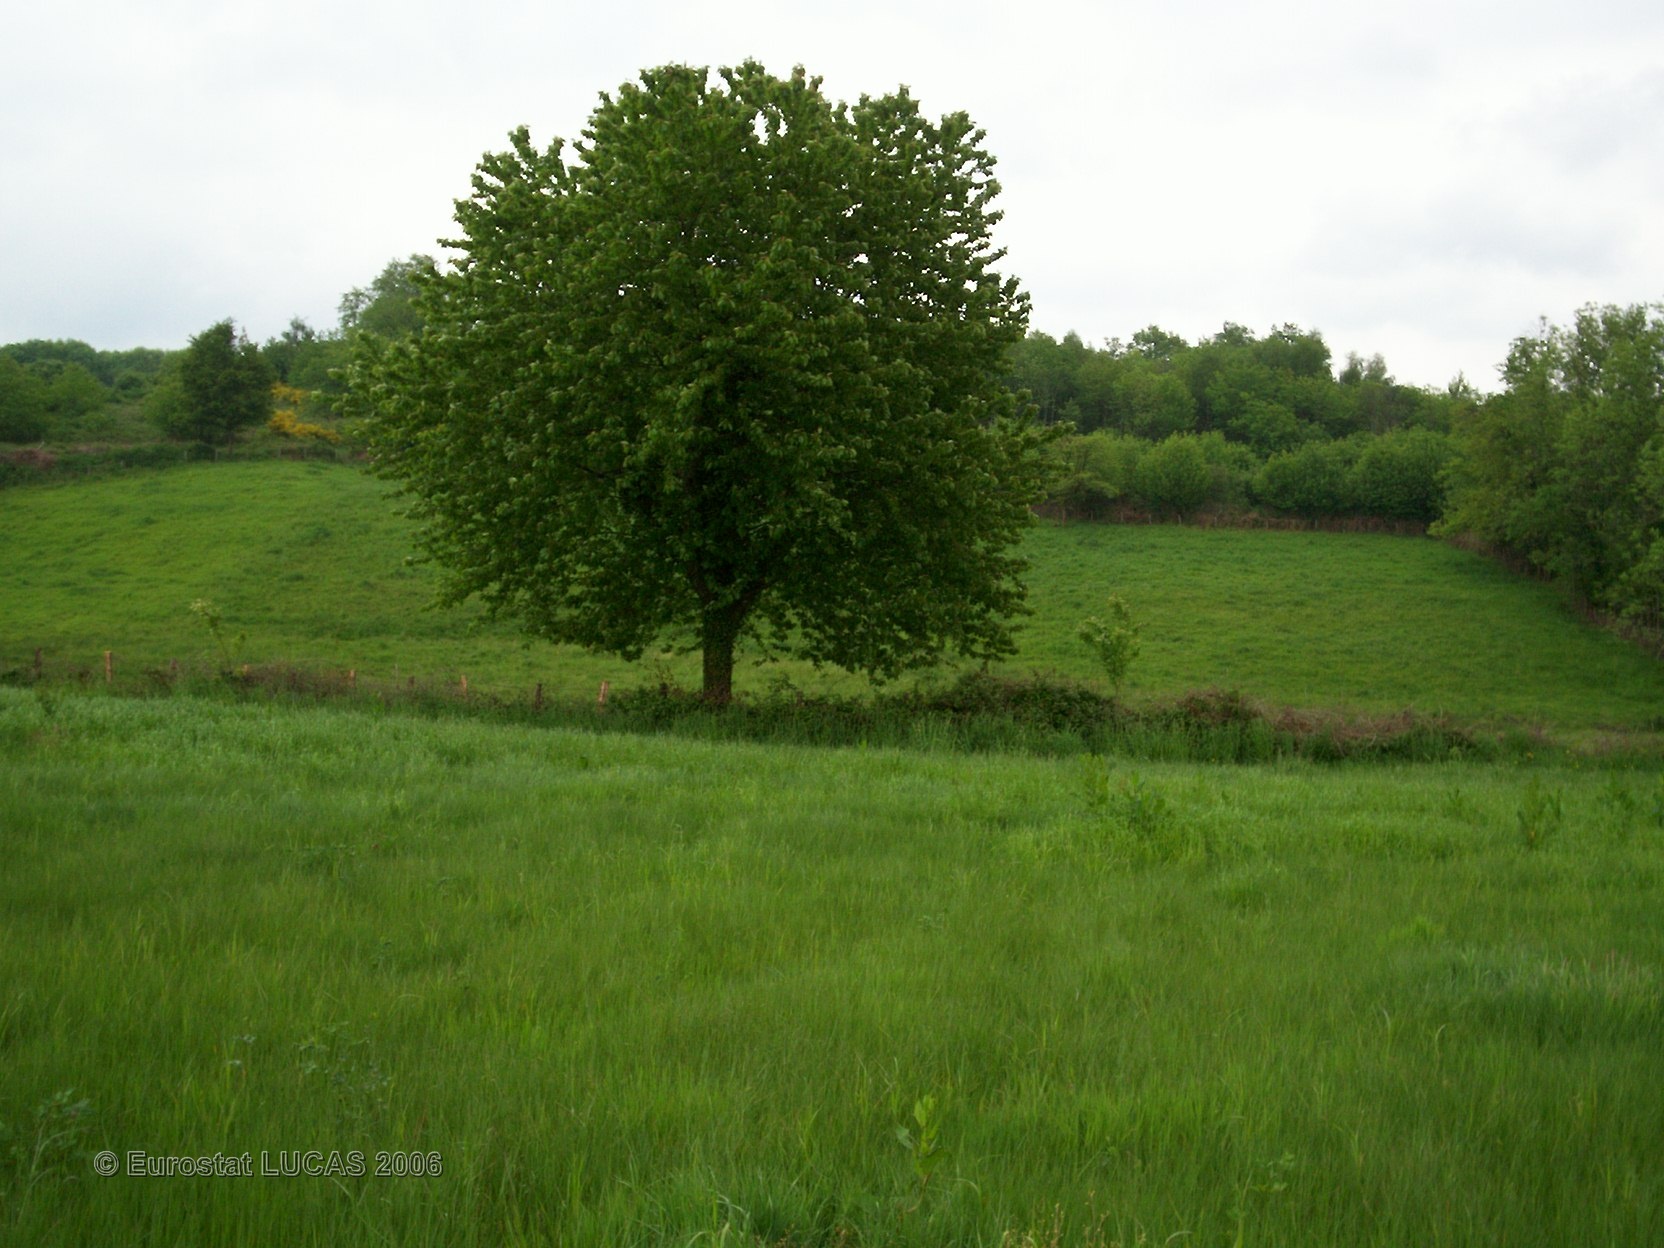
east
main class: Grassland
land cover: Grassland without tree/shrub cover
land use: Agriculture (excluding fallow land and kitchen gardens)
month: May
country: FR
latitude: 45.7317
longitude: 0.5412
